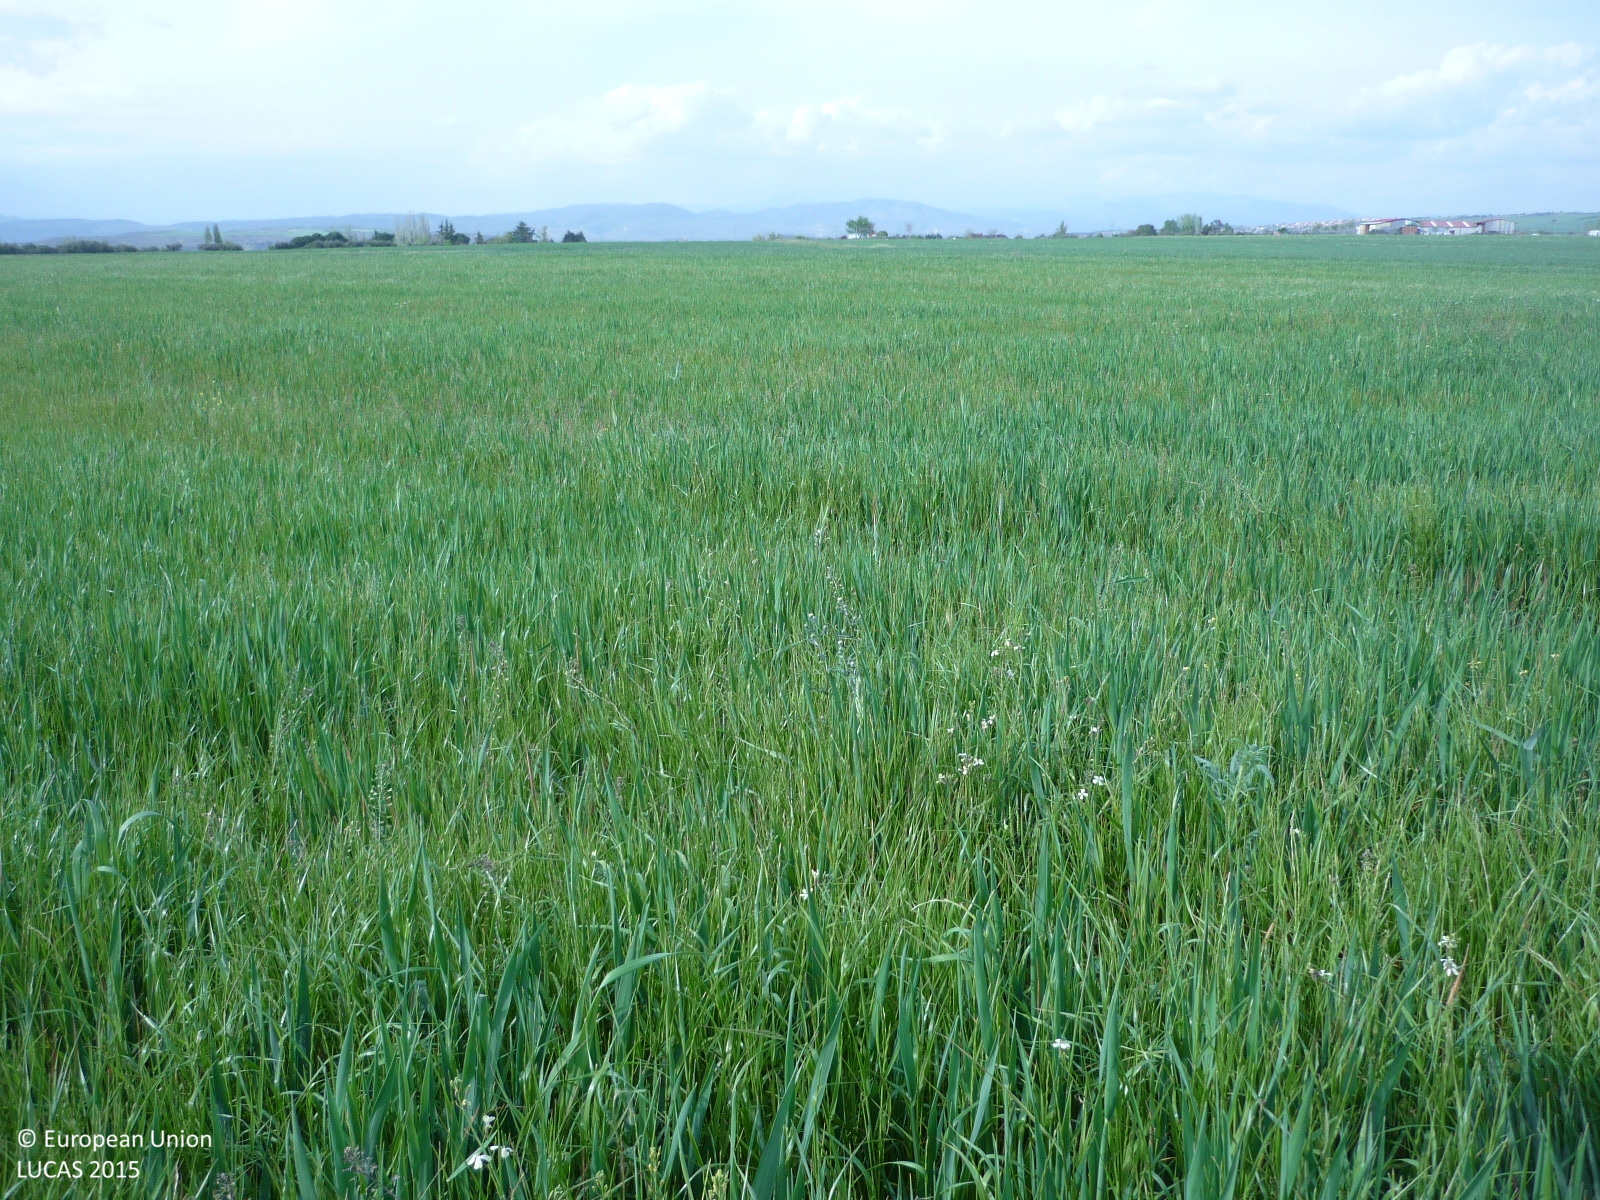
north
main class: Cropland
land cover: Oats
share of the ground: > 75 %
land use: Agriculture (excluding fallow land and kitchen gardens)
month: April
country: ES
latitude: 40.7390
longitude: -3.5032
